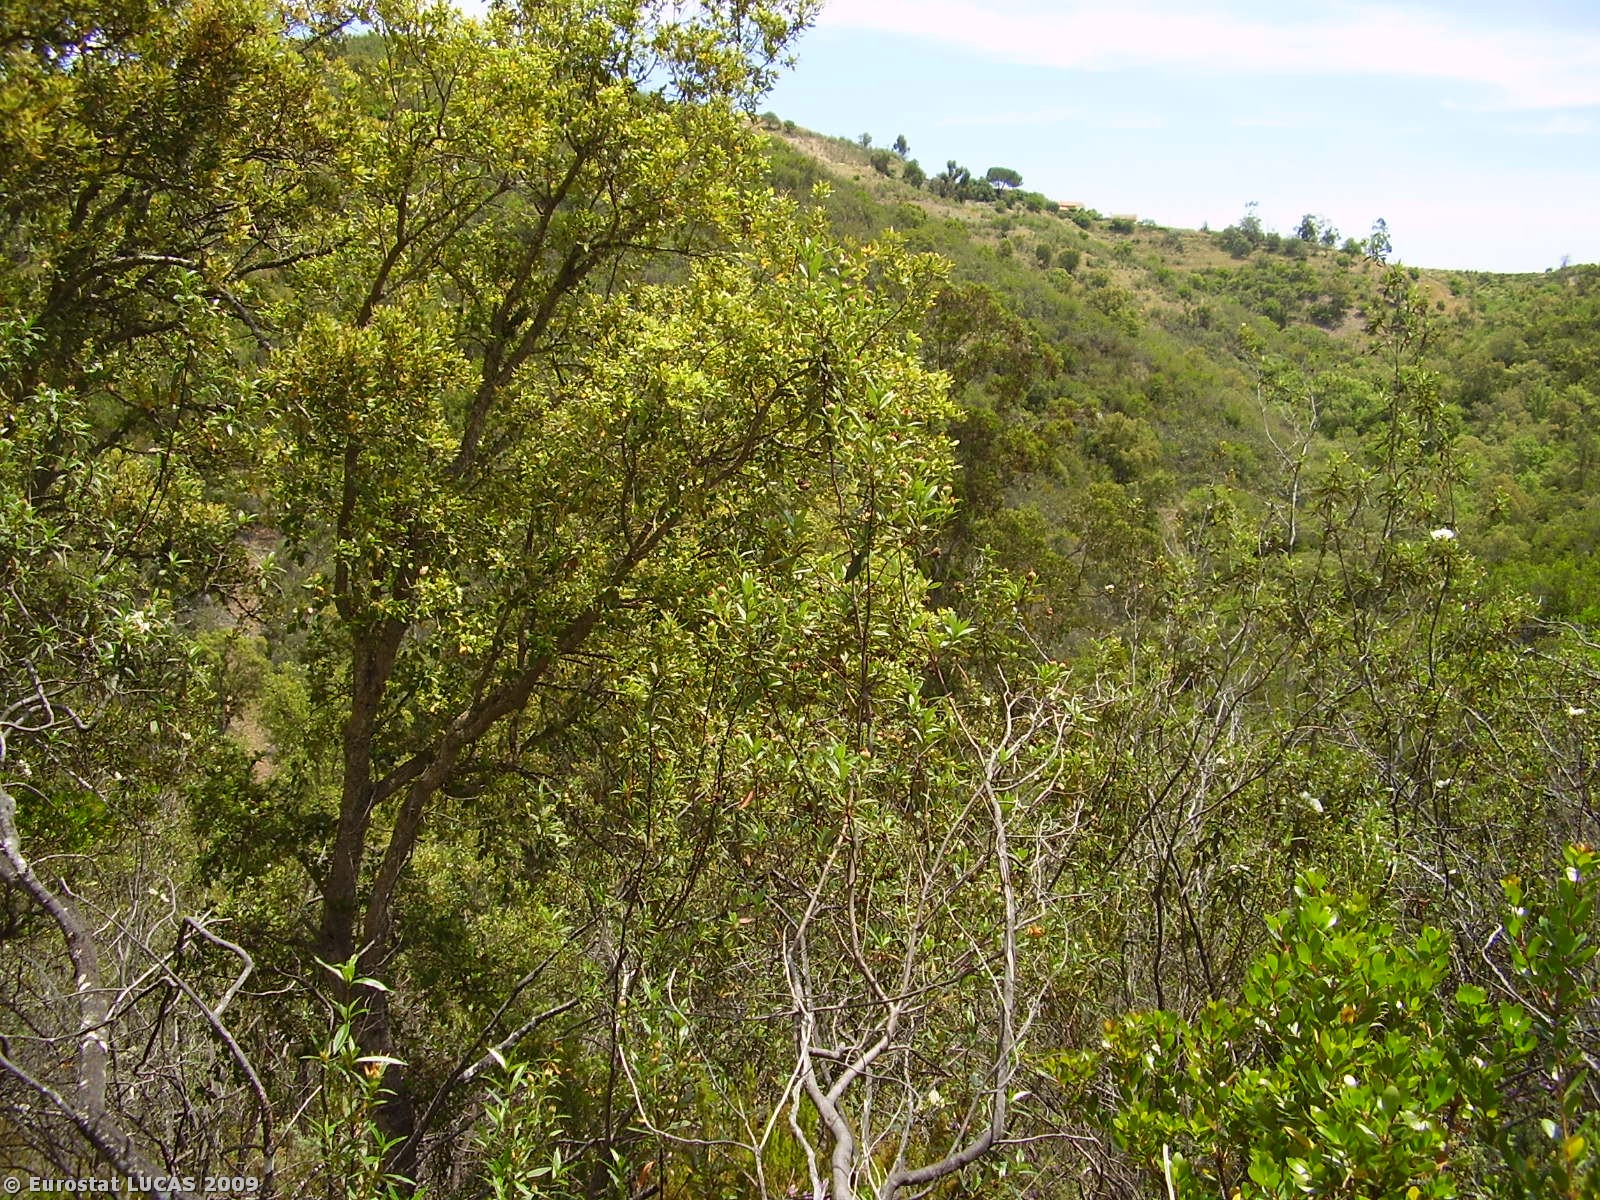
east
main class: Shrubland
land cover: Shrubland with sparse tree cover
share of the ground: > 75 %
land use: Fallow land
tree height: > 5 m
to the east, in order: Shrubland with sparse tree cover; Rivers and streams; Shrubland with sparse tree cover; Tracks; Shrubland with sparse tree cover
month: May
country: PT
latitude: 37.4149
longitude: -8.2261
